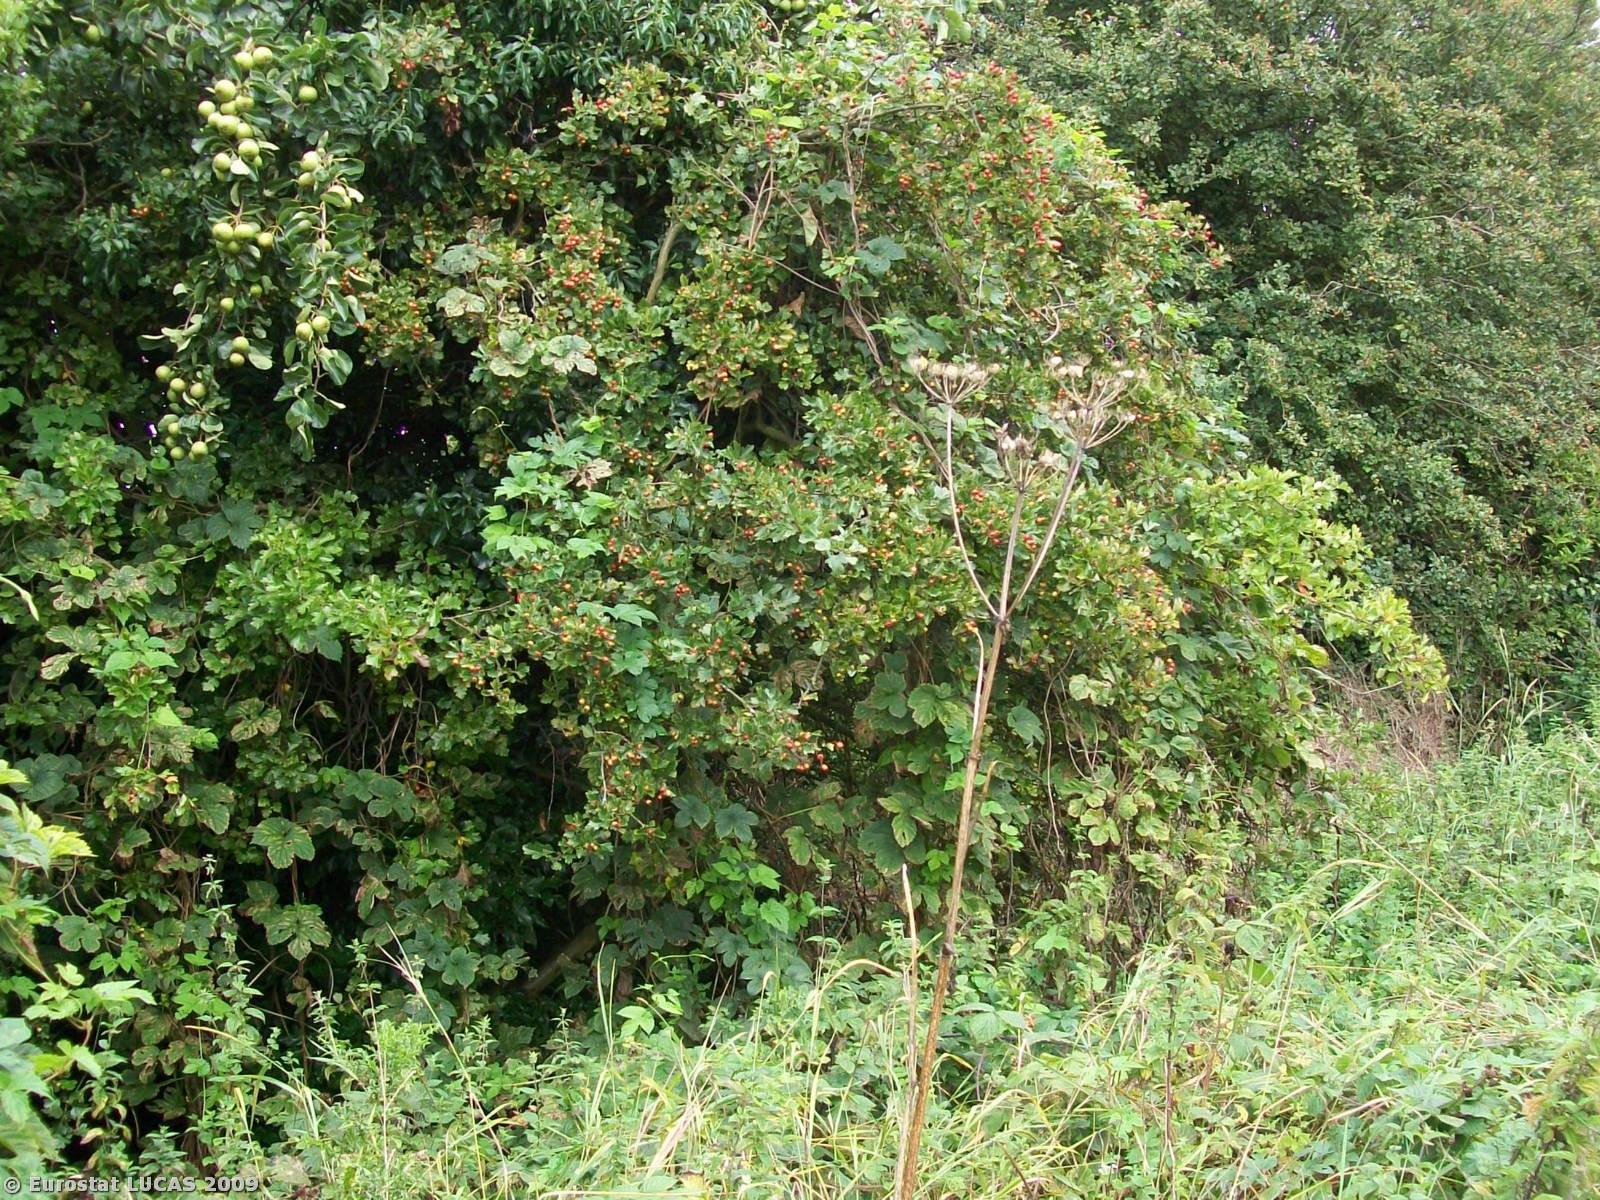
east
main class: Grassland
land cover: Grassland without tree/shrub cover
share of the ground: > 75 %
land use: Agriculture (excluding fallow land and kitchen gardens)
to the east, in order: Grassland without tree/shrub cover; Broadleaved woodland; Grassland without tree/shrub cover; Fences; Grassland without tree/shrub cover; Managed hedges; Grassland without tree/shrub cover
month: August
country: GB
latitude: 52.3171
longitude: 0.0066
